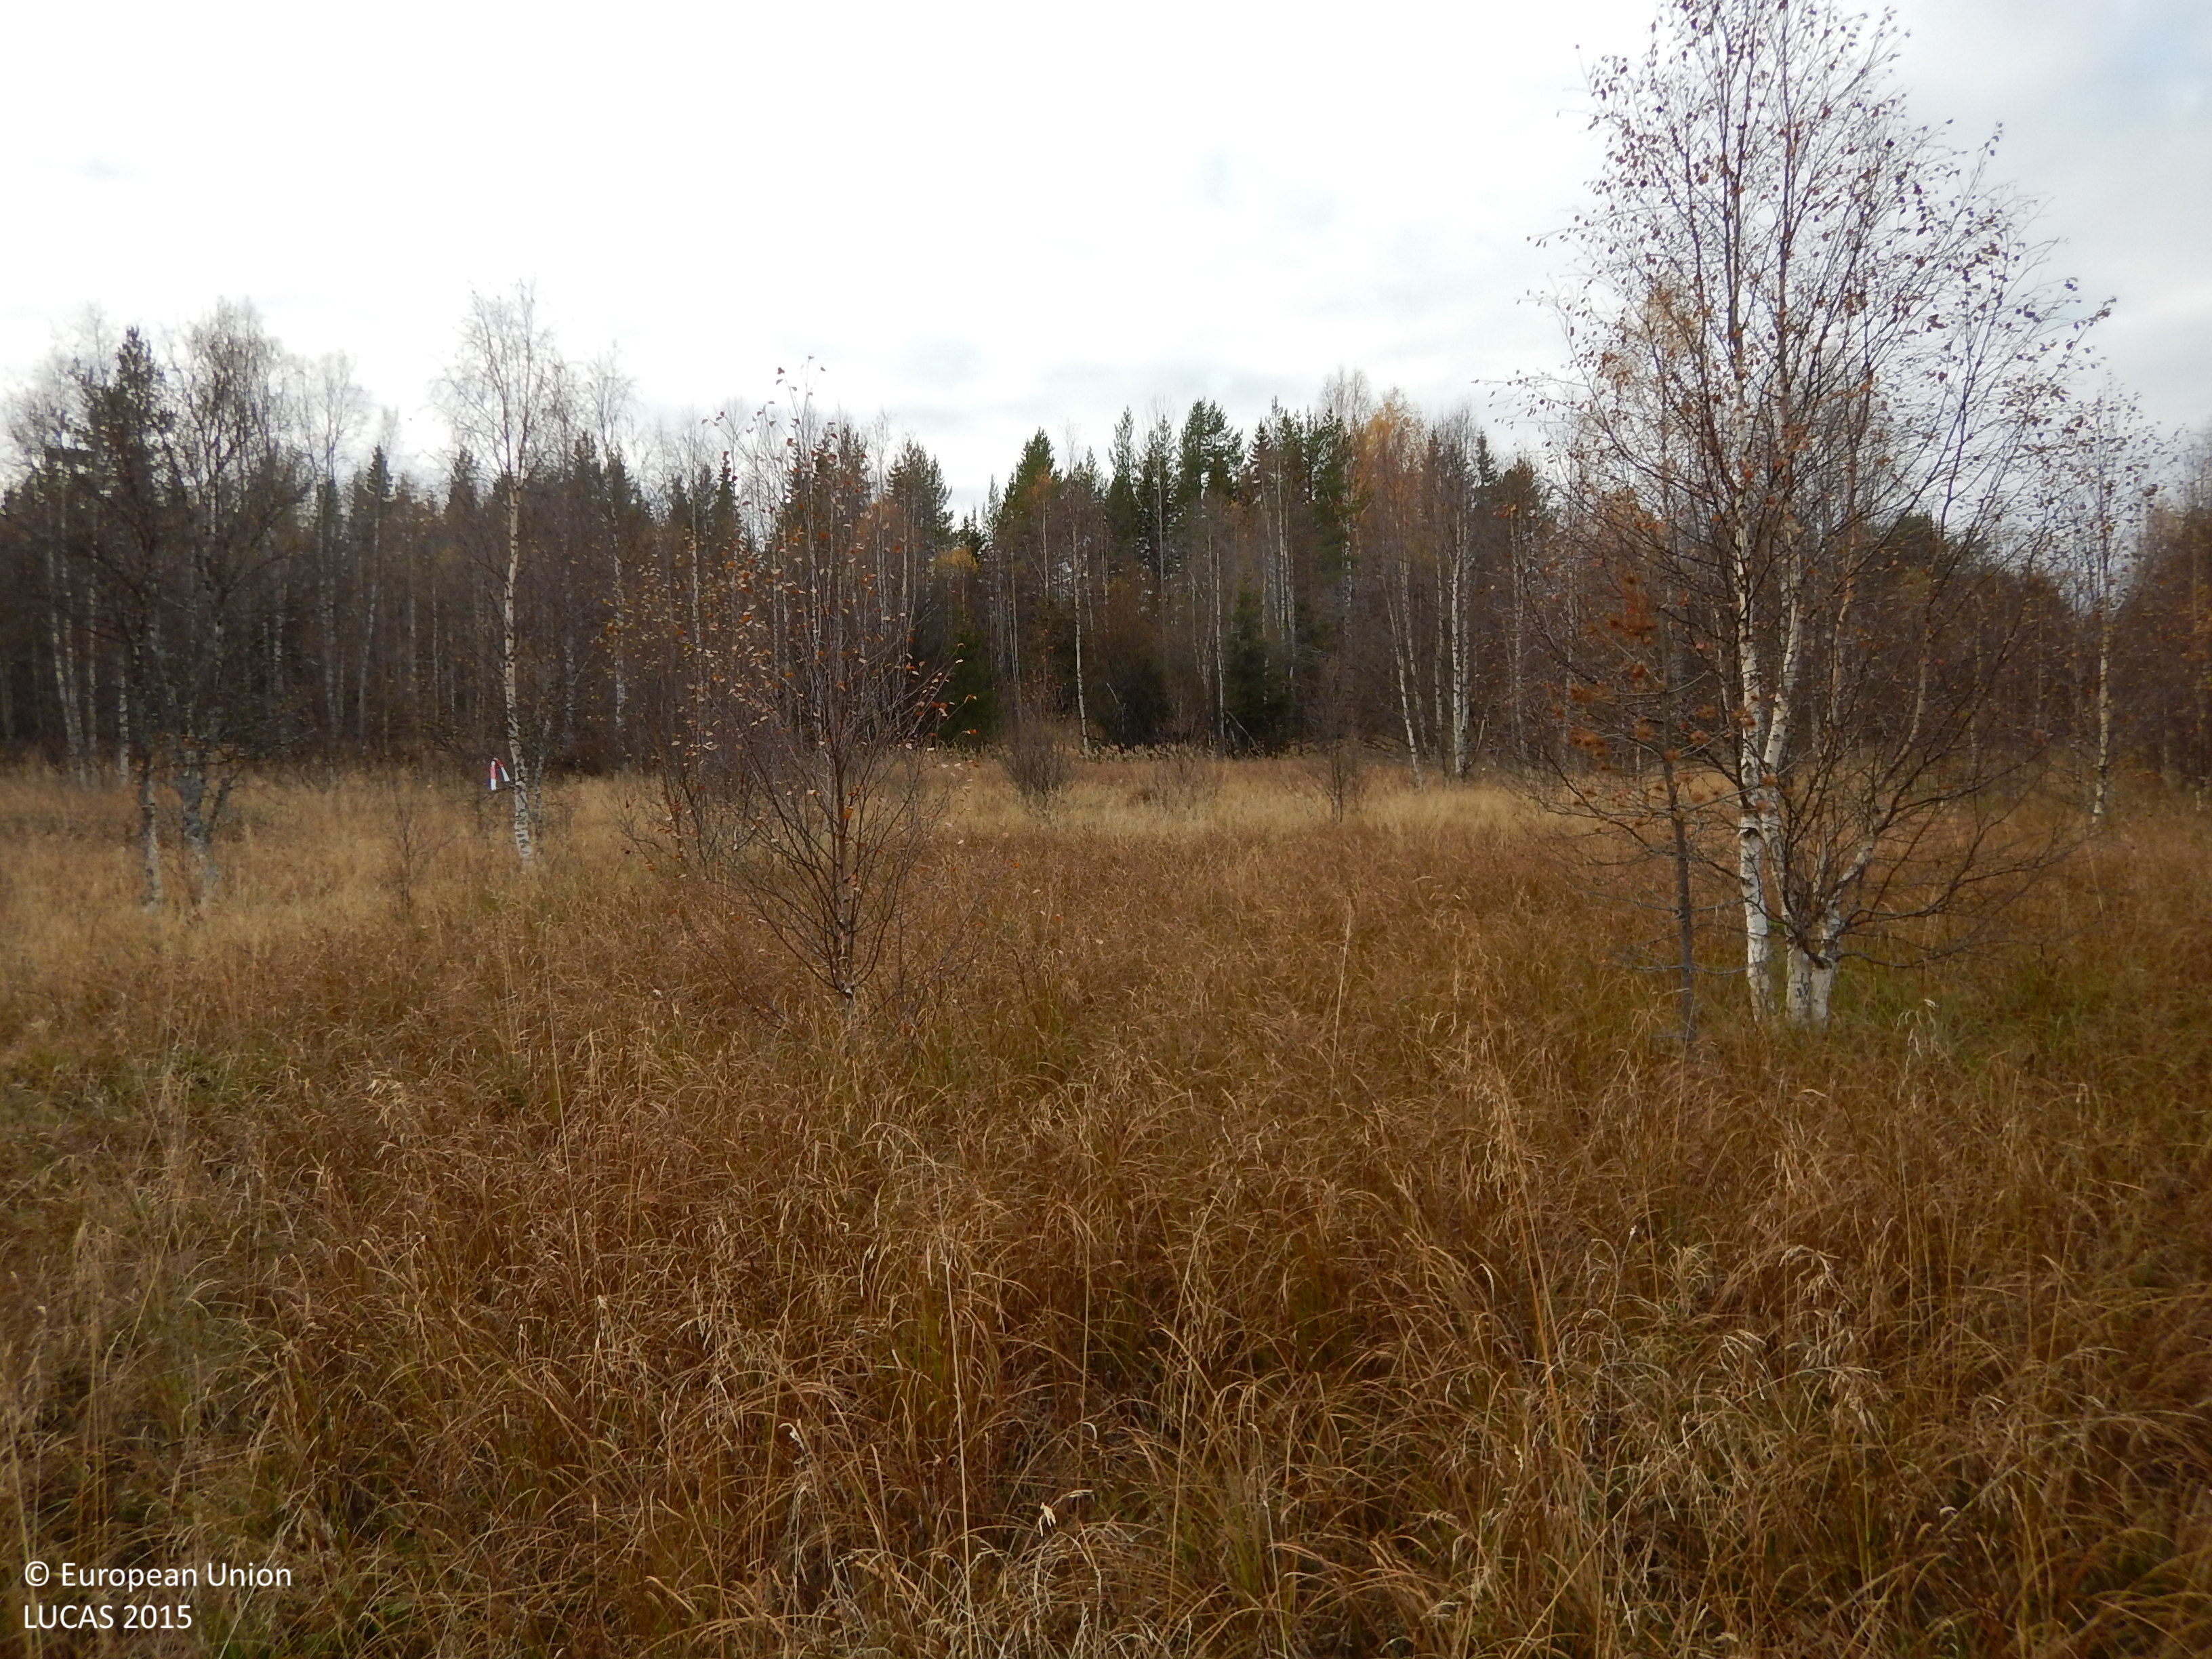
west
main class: Grassland
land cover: Grassland with sparse tree/shrub cover
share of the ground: > 75 %
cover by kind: herbaceous plants 70 %, lichens and mosses 20 %, broadleaved forest trees 5 %, shrubs 5 %
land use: Abandoned areas
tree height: > 5 m
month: October
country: SE
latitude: 65.1274
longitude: 21.0336
